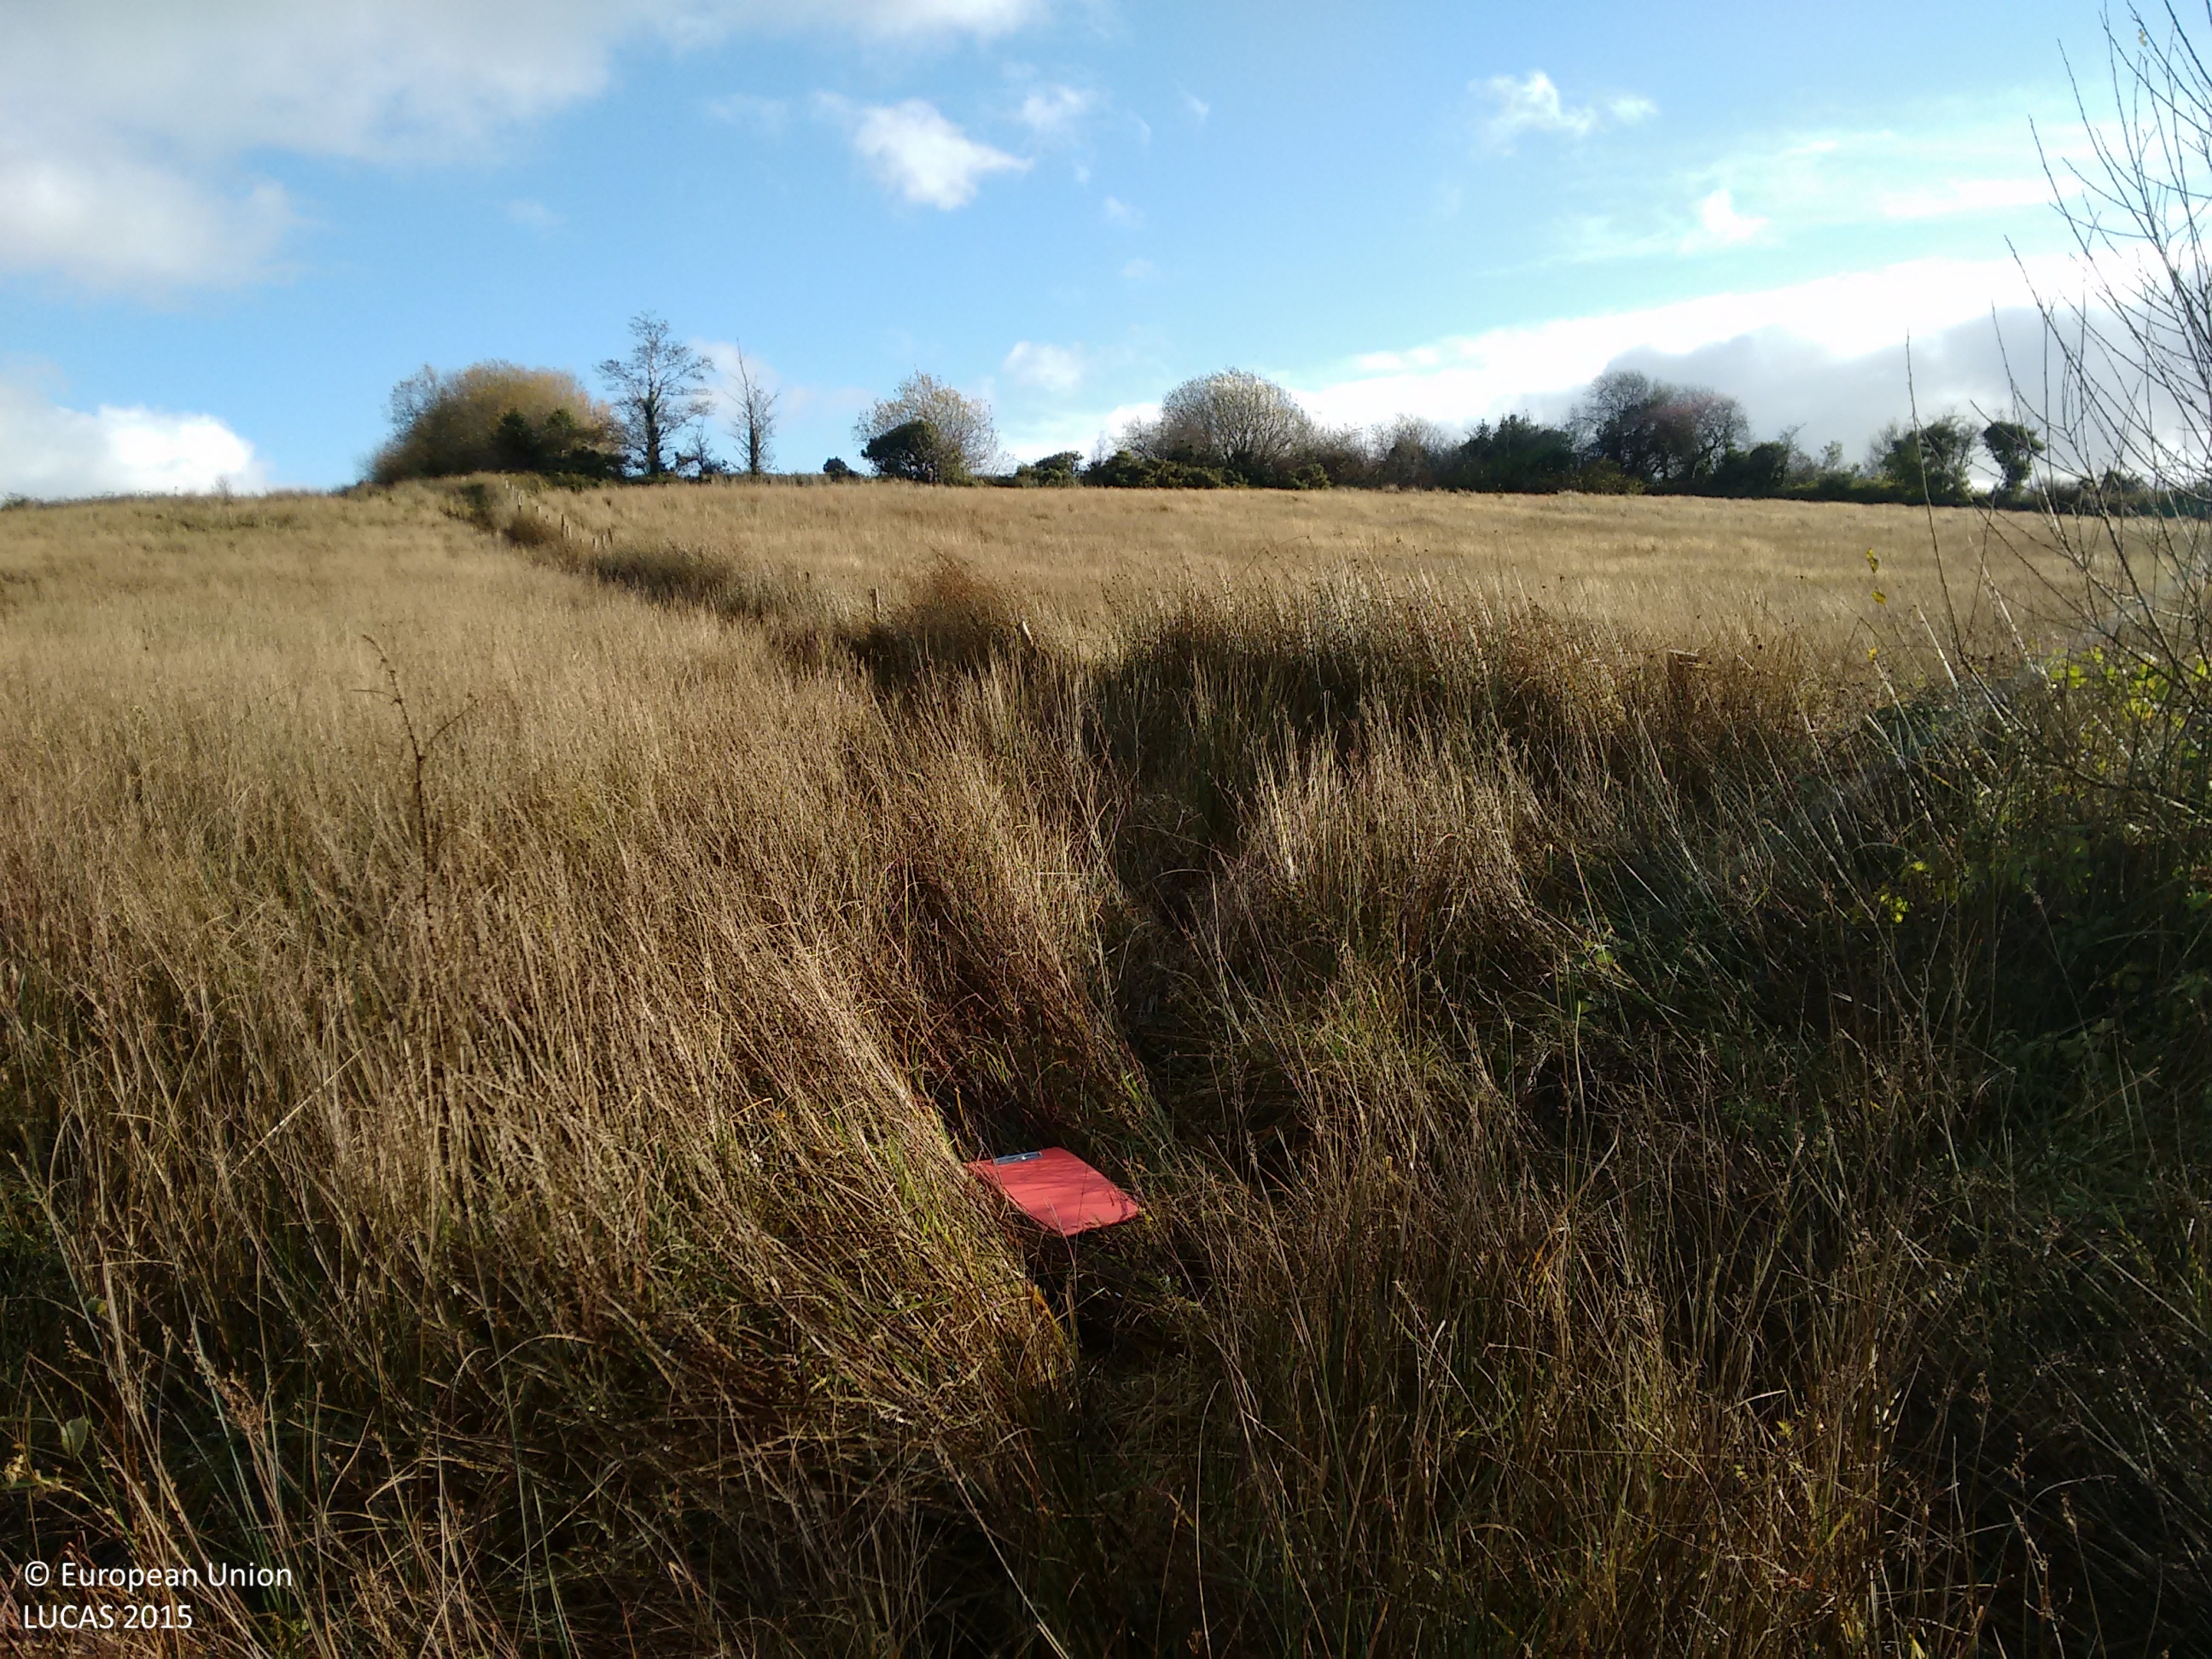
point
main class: Grassland
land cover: Grassland without tree/shrub cover
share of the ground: > 75 %
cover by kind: herbaceous plants 100 %
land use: Agriculture (excluding fallow land and kitchen gardens)
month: November
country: IE
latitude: 54.0615
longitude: -8.0355
